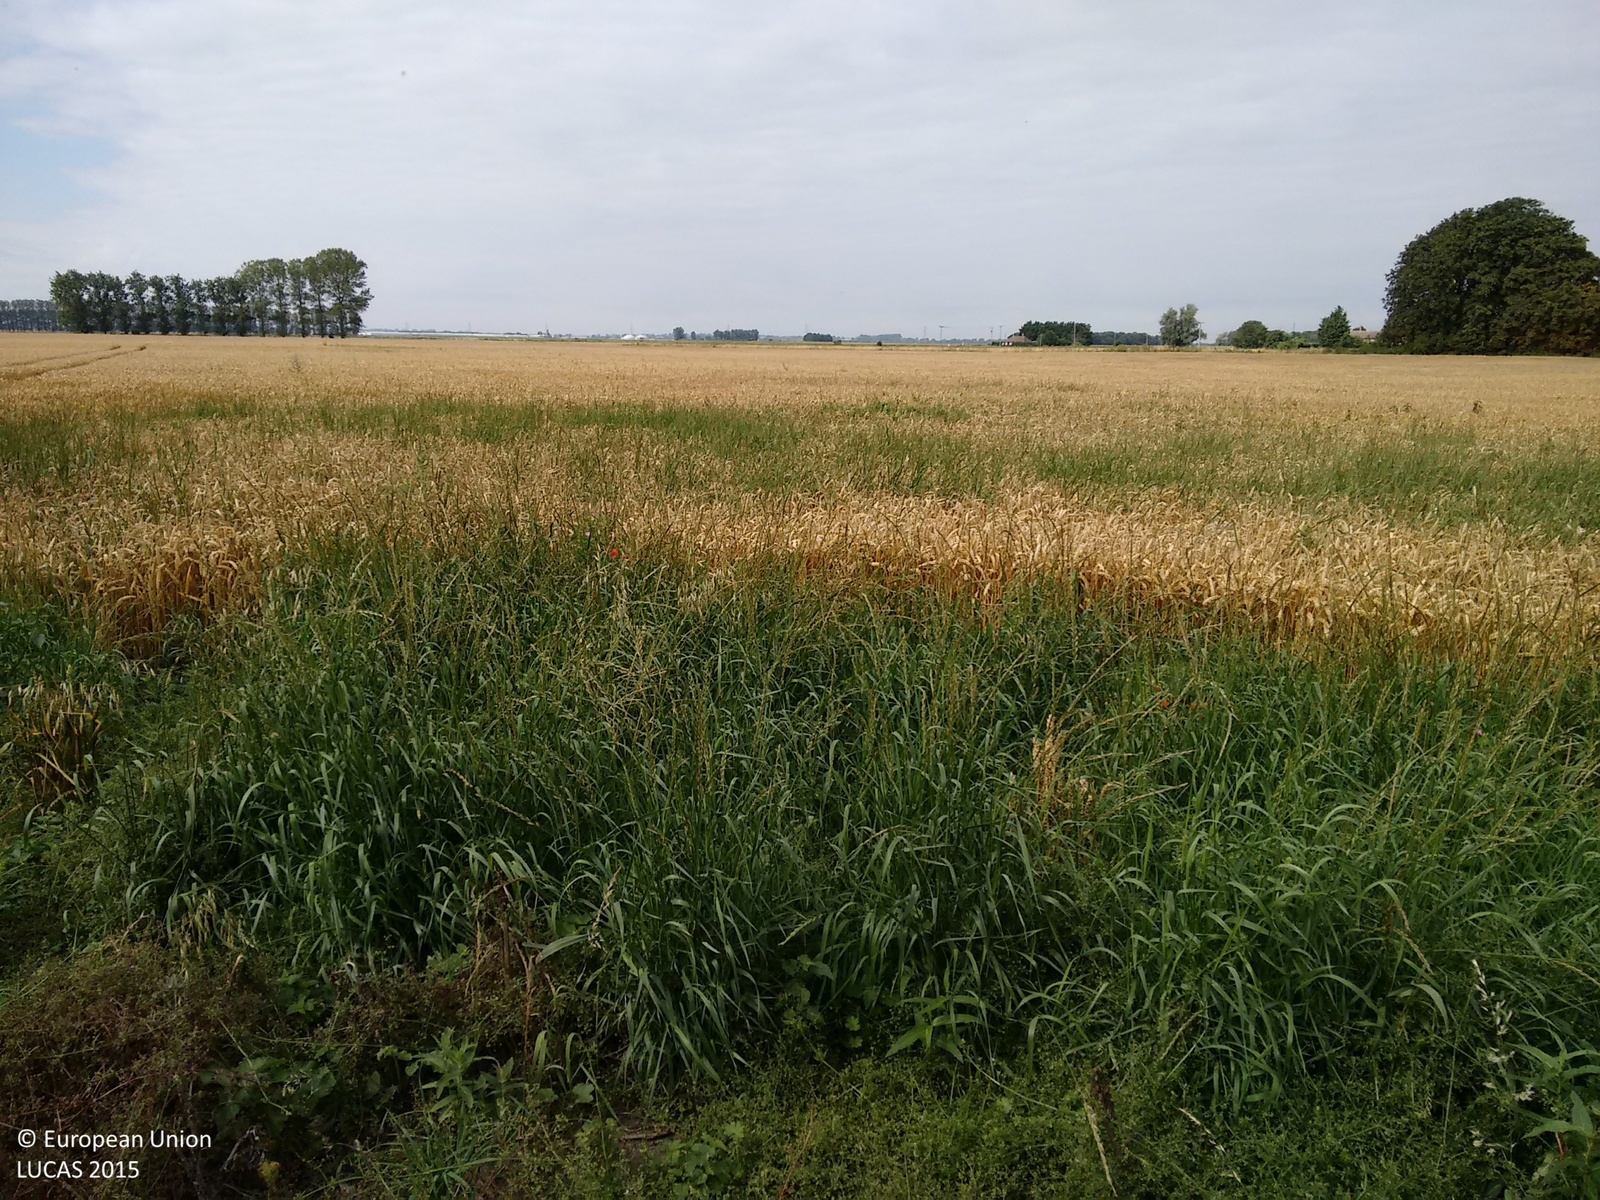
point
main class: Cropland
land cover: Common wheat
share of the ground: > 75 %
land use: Agriculture (excluding fallow land and kitchen gardens)
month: August
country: GB
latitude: 52.4755
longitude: 0.3870
